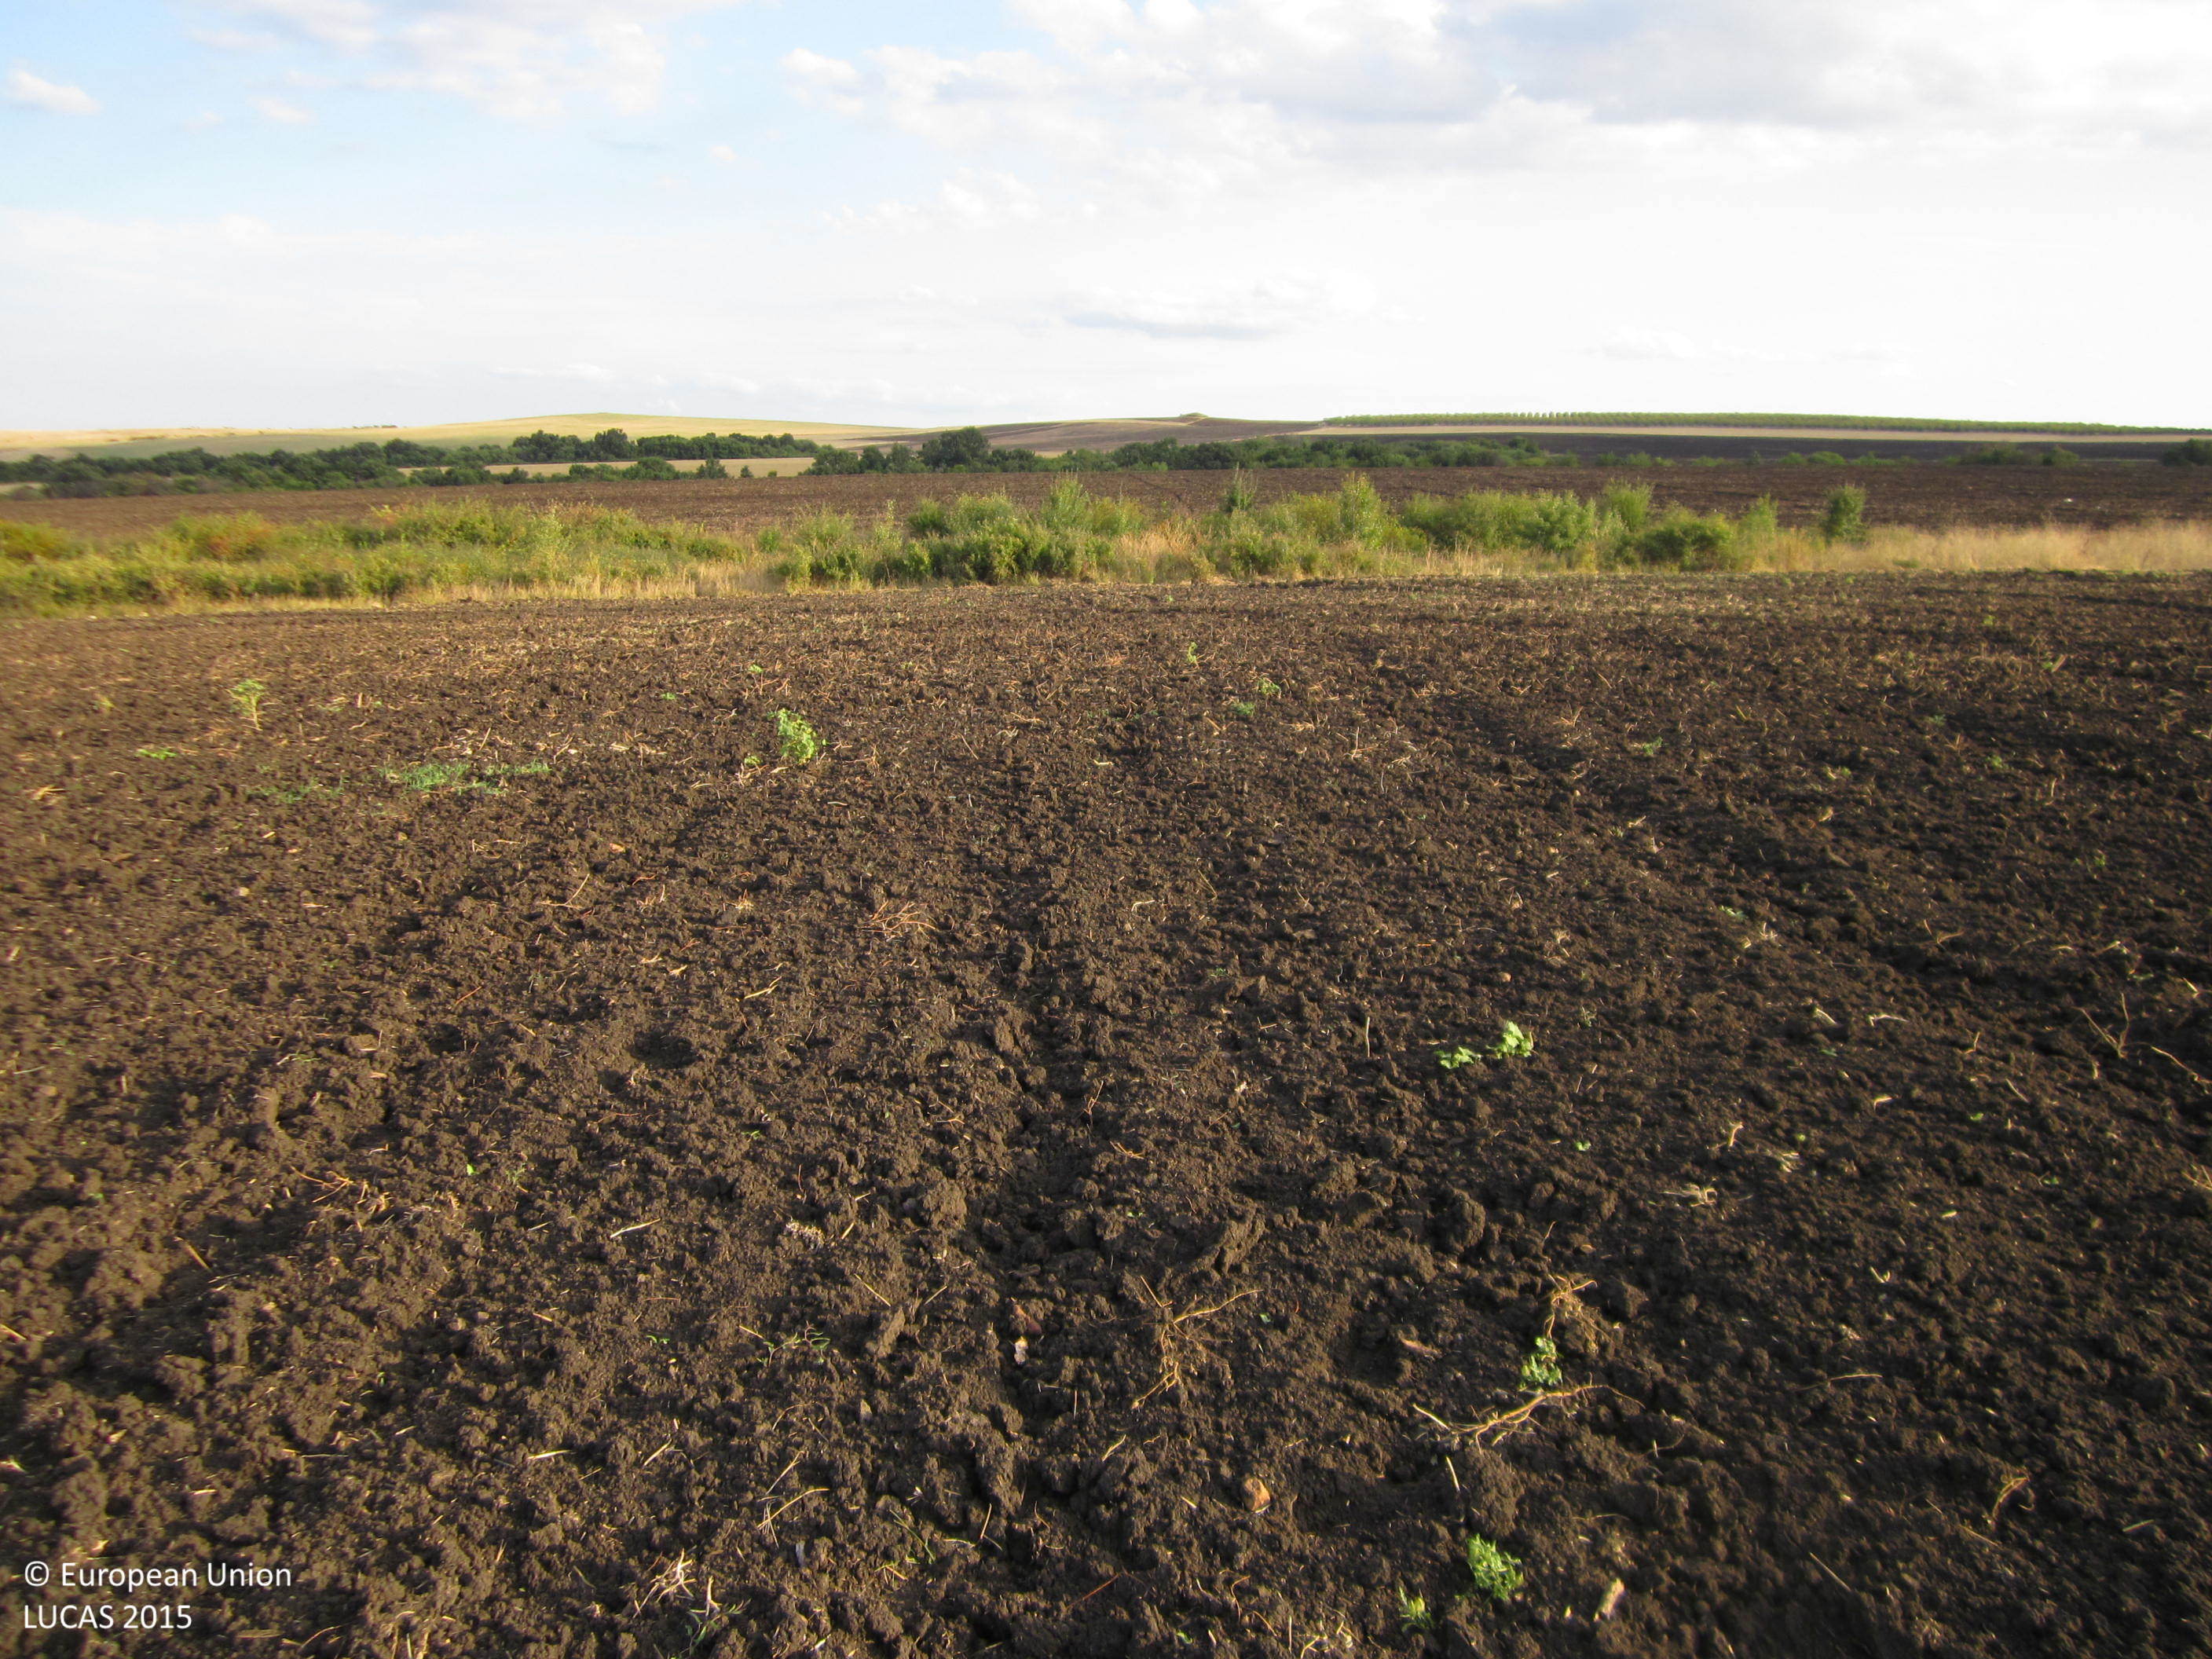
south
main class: Cropland
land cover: Sunflower
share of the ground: < 10 %
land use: Agriculture (excluding fallow land and kitchen gardens)
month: September
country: BG
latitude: 42.6207
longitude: 27.1171
